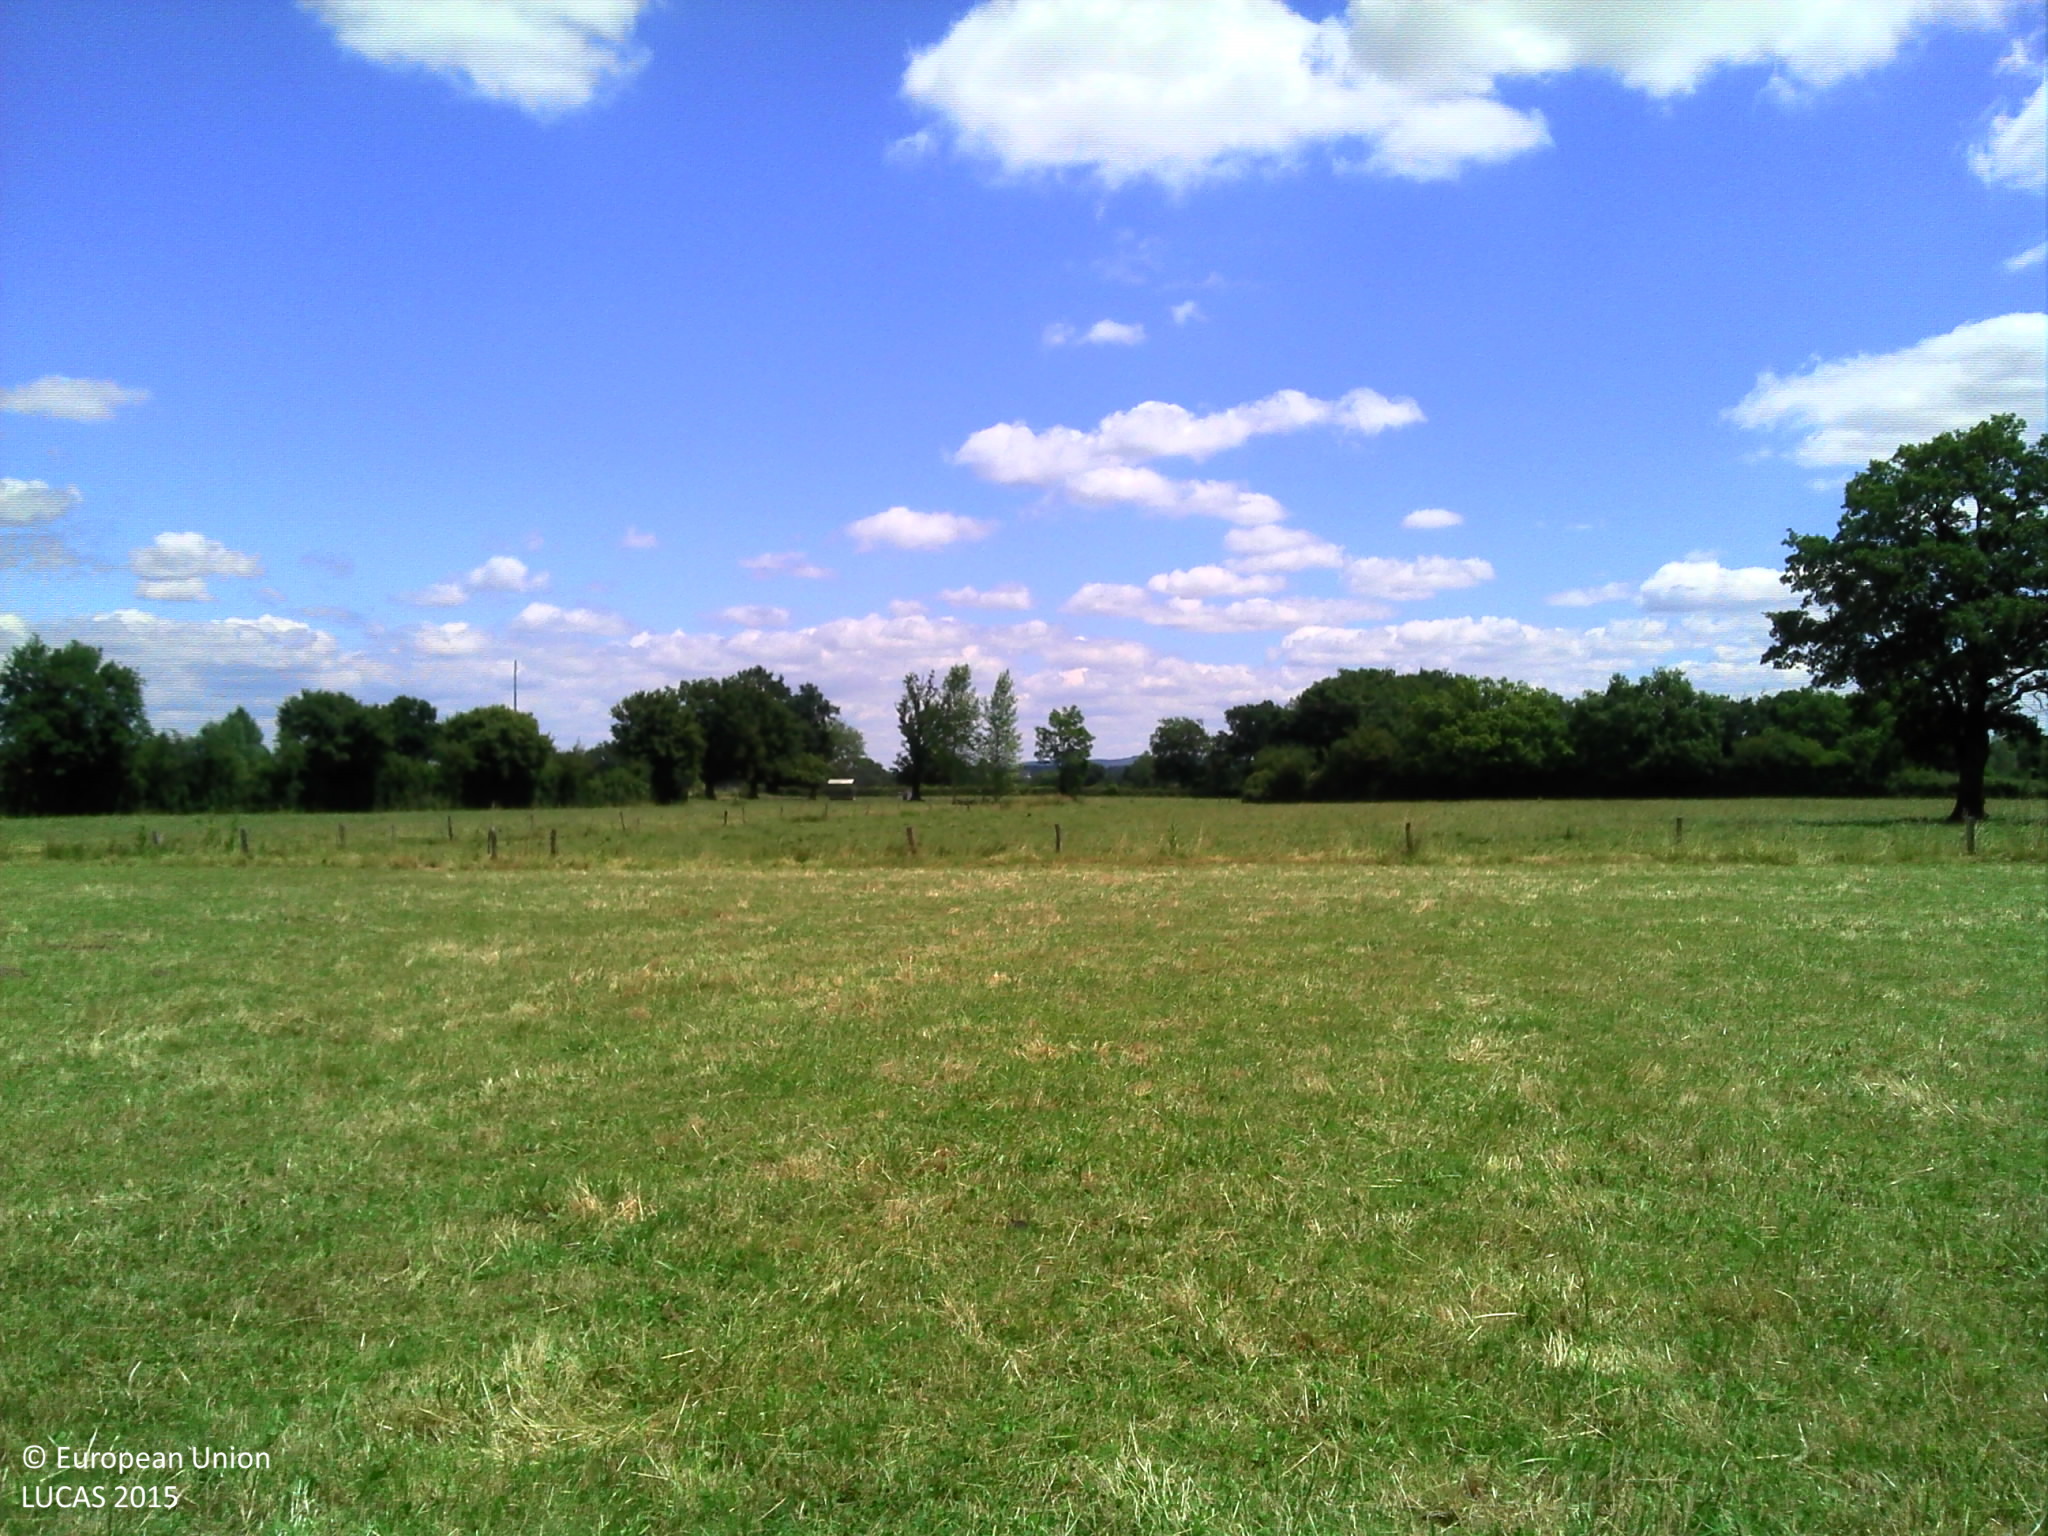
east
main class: Grassland
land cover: Grassland without tree/shrub cover
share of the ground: > 75 %
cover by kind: herbaceous plants 100 %
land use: Agriculture (excluding fallow land and kitchen gardens)
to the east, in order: Grassland without tree/shrub cover; Fences; Rivers and streams; Fences; Grassland without tree/shrub cover; Fences; Rivers and streams; Abandoned hedges; Fences; Grassland without tree/shrub cover
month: June
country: FR
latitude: 46.6509
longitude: 3.6617
